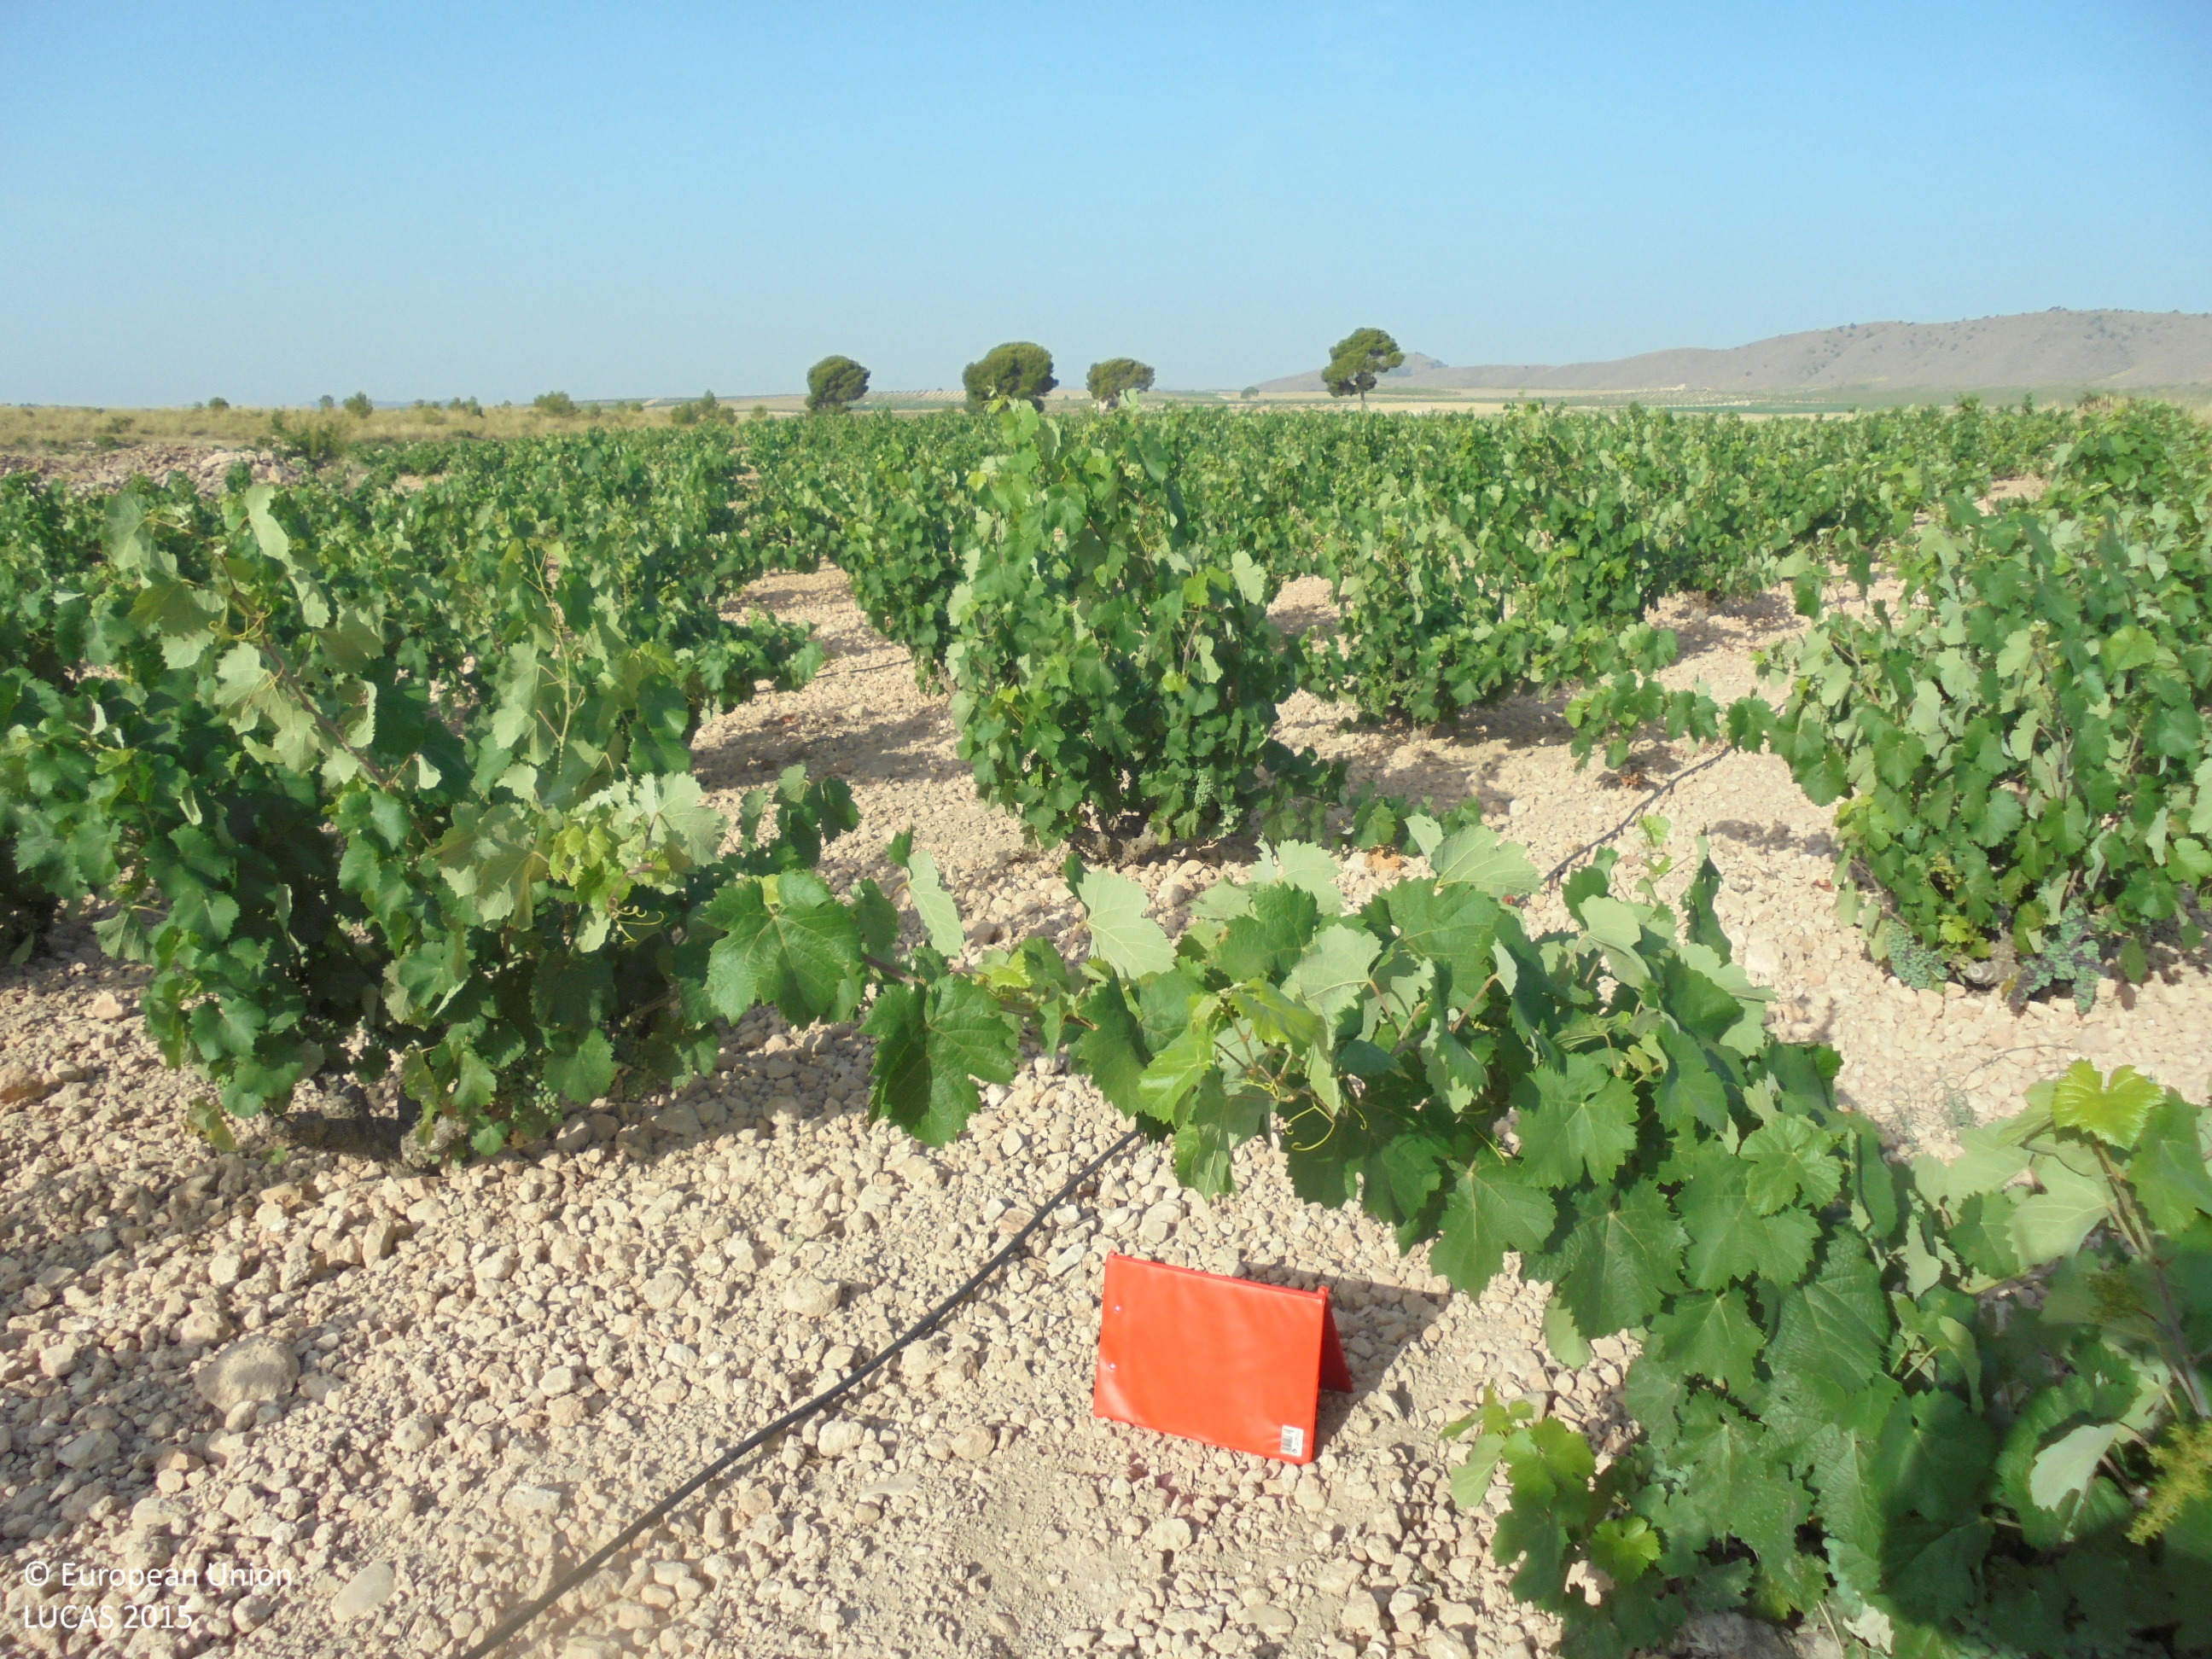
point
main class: Cropland
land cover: Vineyards
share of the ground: 25 - 50 %
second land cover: Other bare soil
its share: > 75 %
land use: Agriculture (excluding fallow land and kitchen gardens)
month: July
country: ES
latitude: 38.6437
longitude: -1.6101
